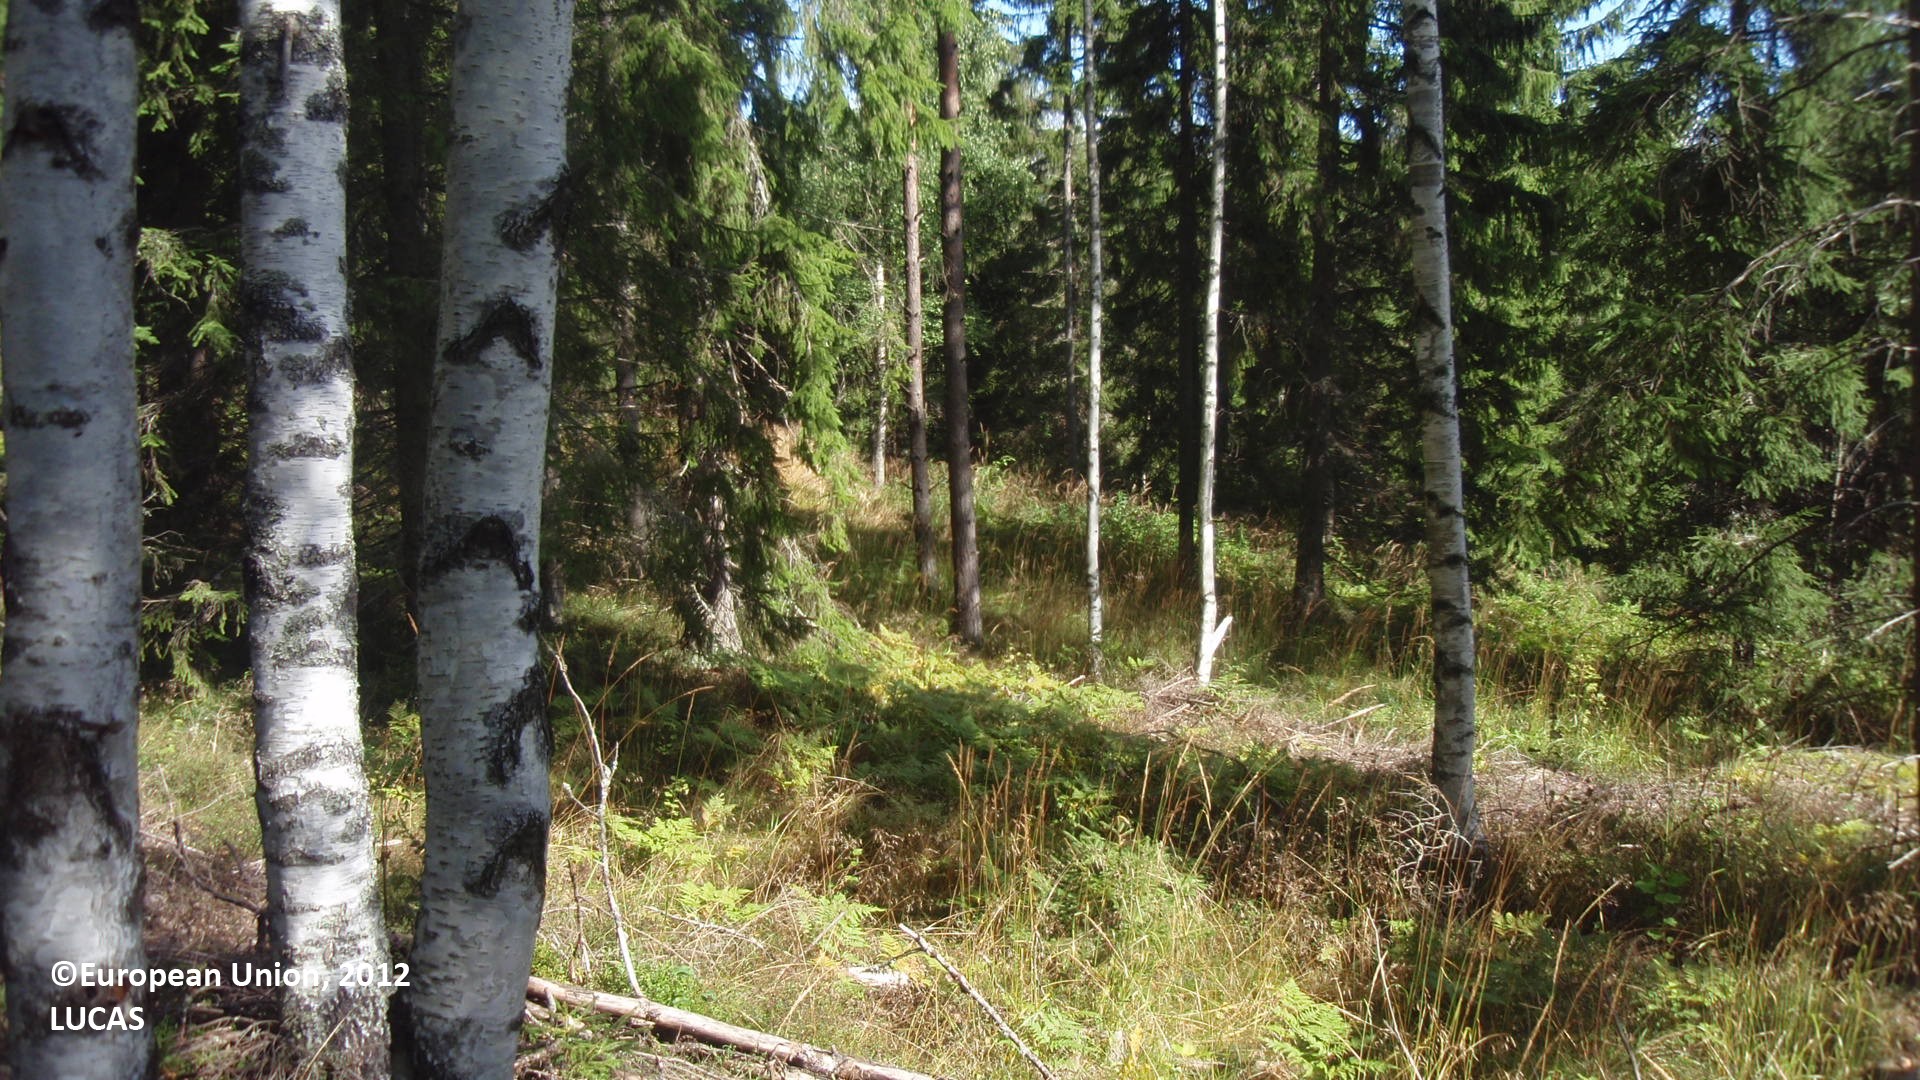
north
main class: Woodland
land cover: Spruce dominated mixed woodland
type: boreal forest
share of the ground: 50 - 75 %
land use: Forestry
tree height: > 5 m
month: August
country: FI
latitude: 60.5683
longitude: 27.3863
